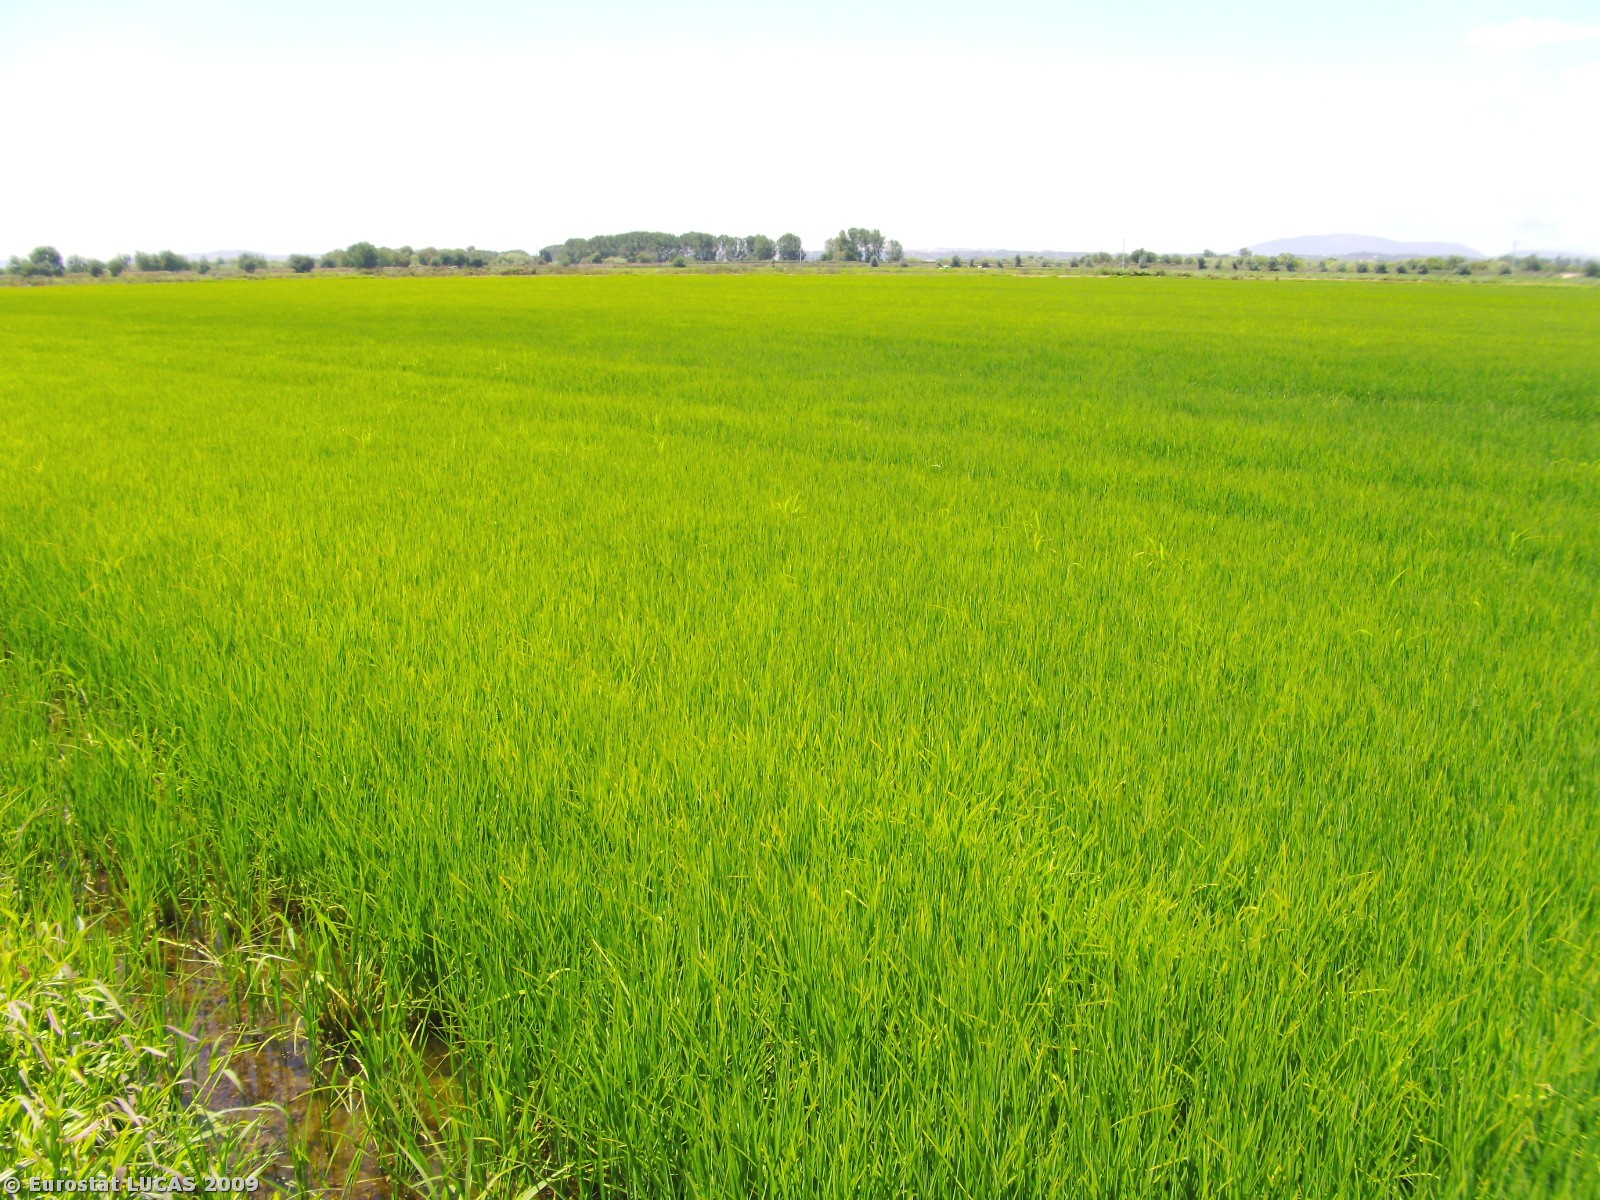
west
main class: Cropland
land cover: Rice
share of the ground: > 75 %
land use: Agriculture (excluding fallow land and kitchen gardens)
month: July
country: PT
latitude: 39.0204
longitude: -8.8177
